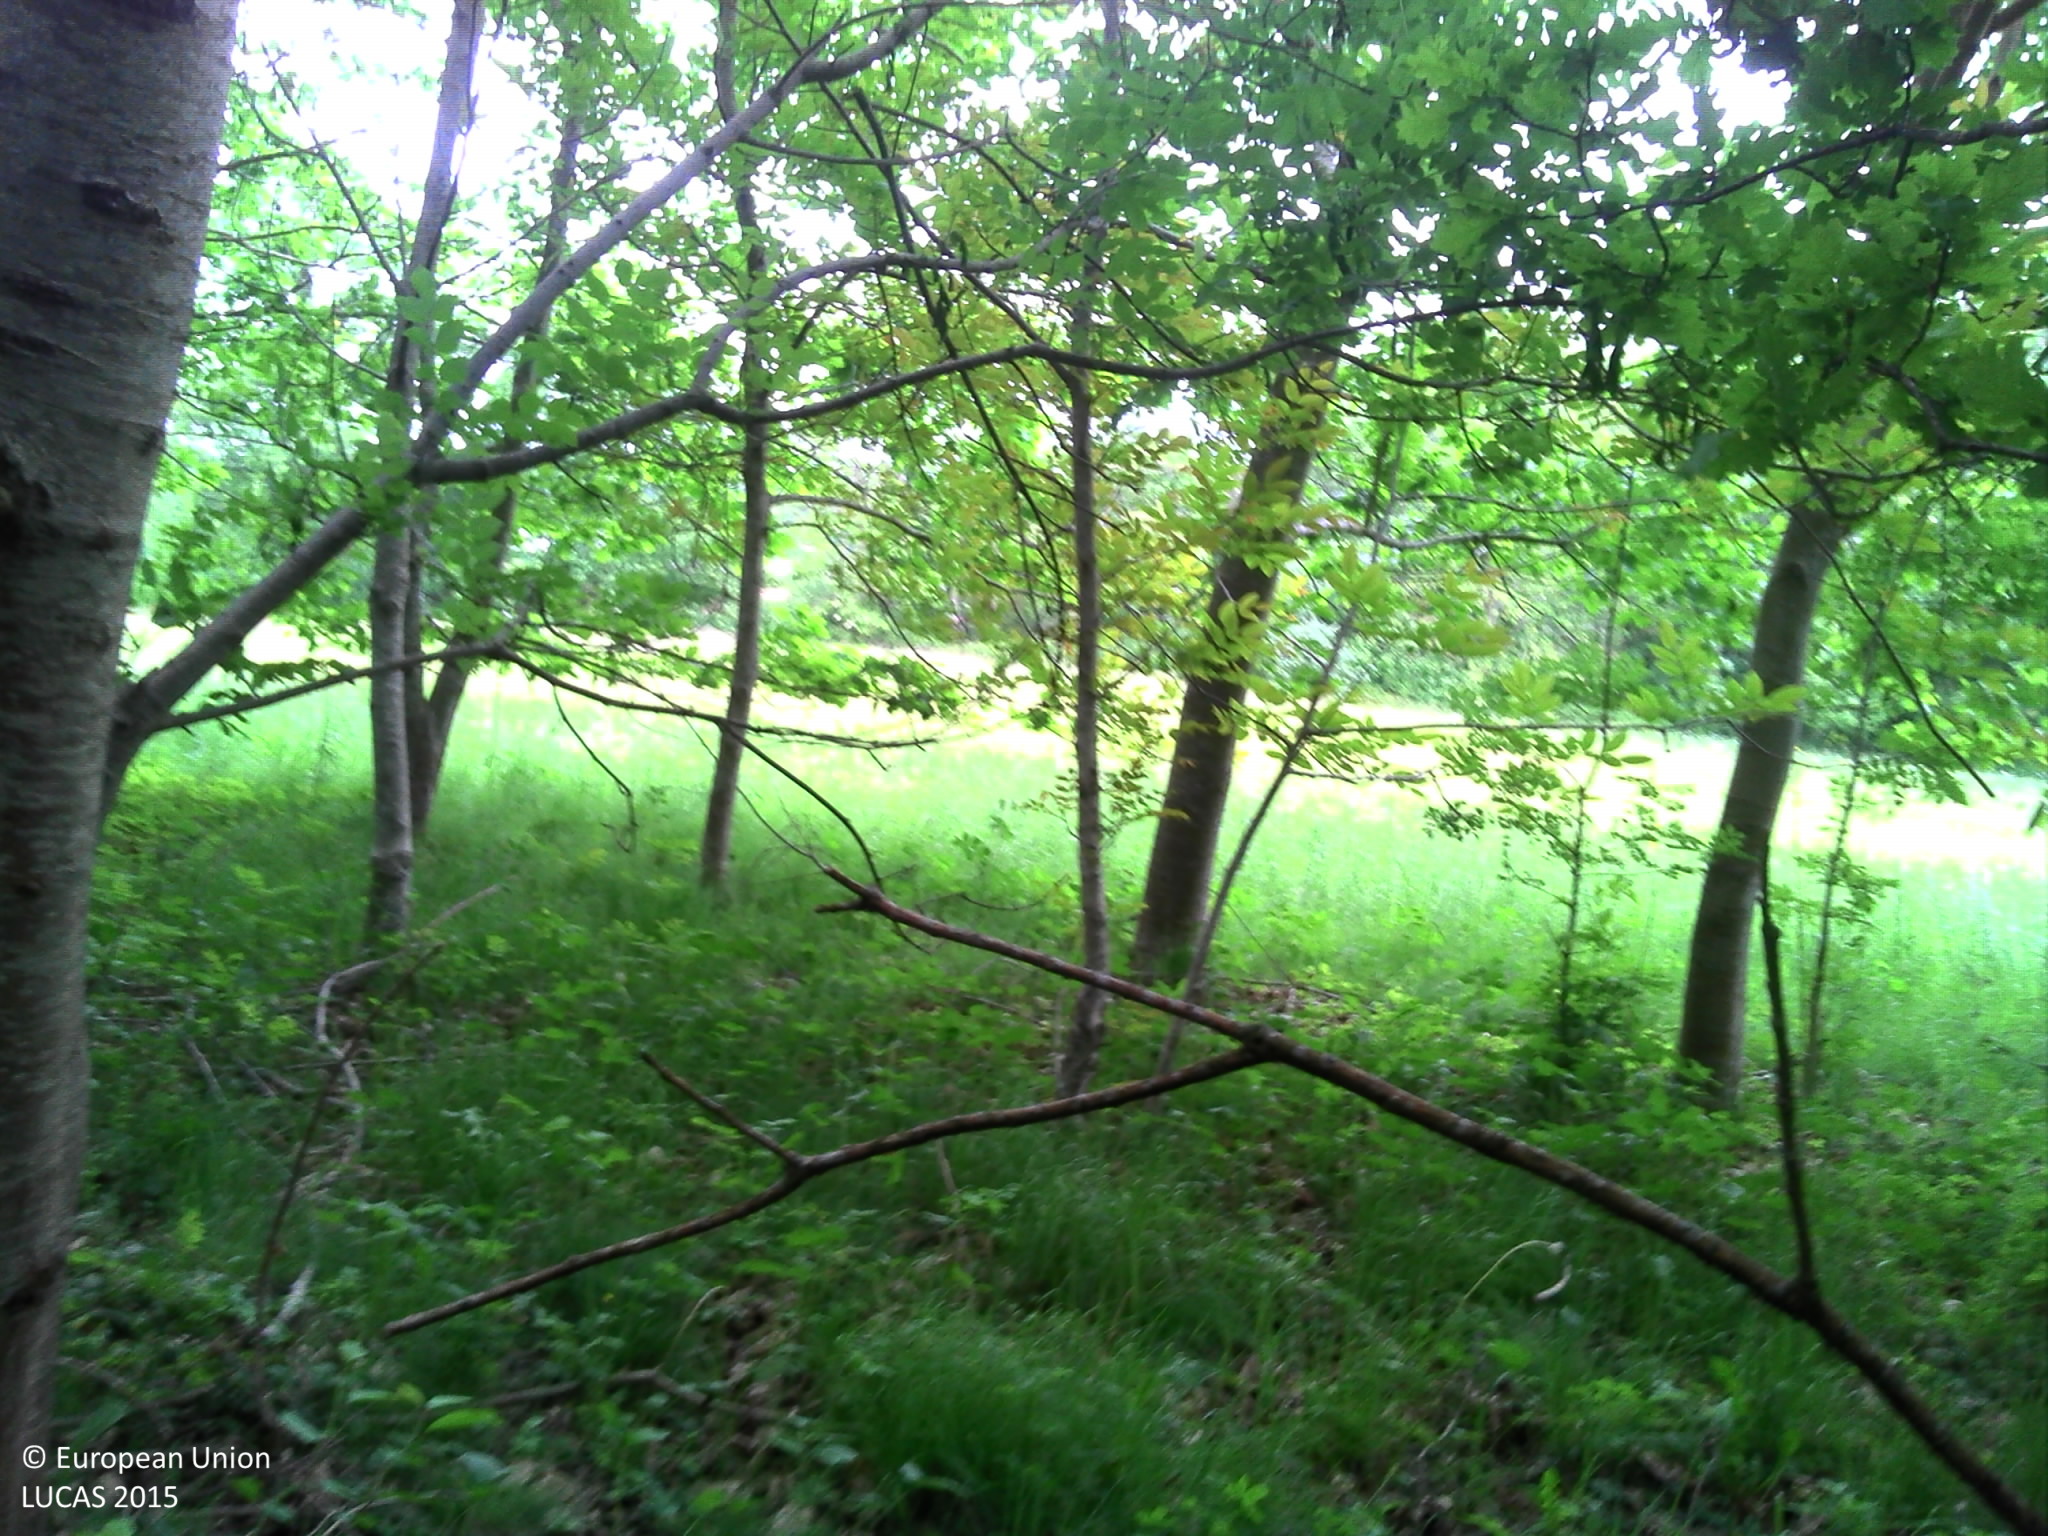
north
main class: Woodland
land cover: Broadleaved woodland
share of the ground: > 75 %
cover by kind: broadleaved forest trees 85 %, shrubs 10 %, herbaceous plants 5 %
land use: Forestry
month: May
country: FR
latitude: 49.3107
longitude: 0.0242
